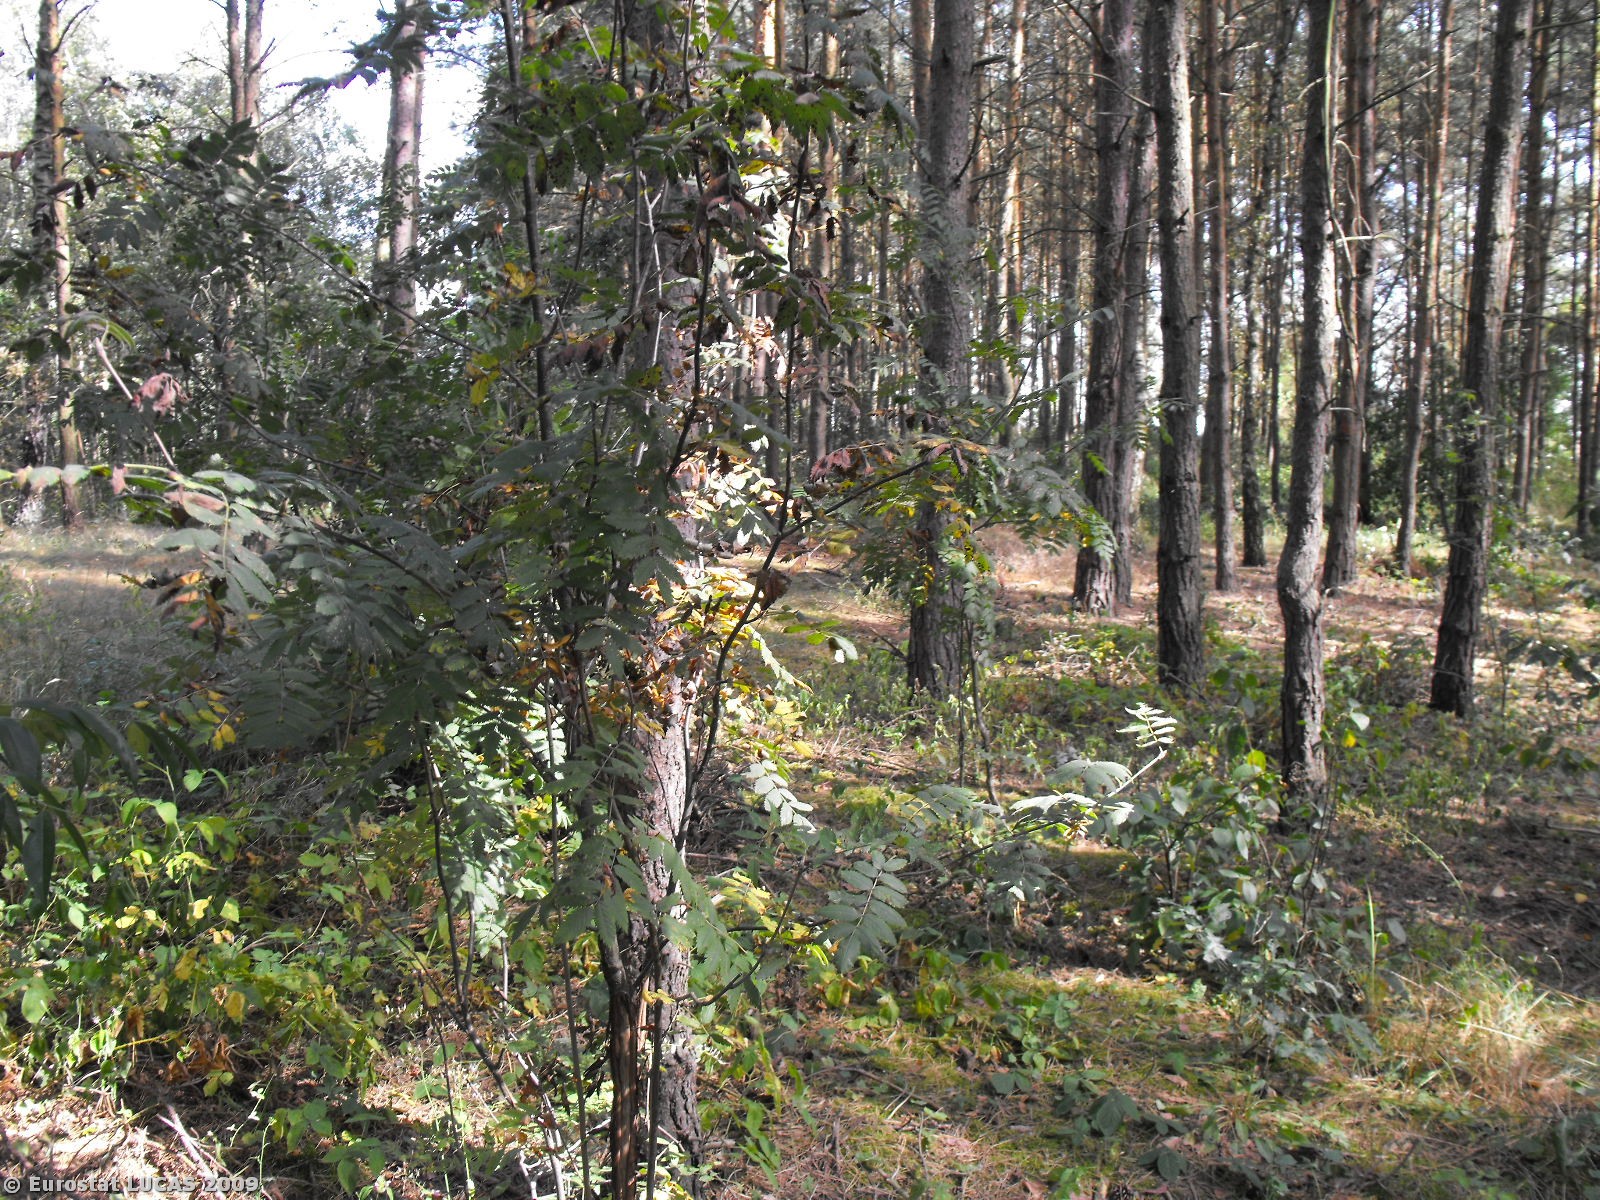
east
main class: Woodland
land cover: Mixed woodland
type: hemiboreal forest and nemoral coniferous forest and mixed broadleaved-coniferous forest
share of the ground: > 75 %
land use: Forestry
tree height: > 5 m
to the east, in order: Mixed woodland; Tracks; Mixed woodland; Grass margins; Barley; Grass margins; Fences; Other fruit trees and berries
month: August
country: PL
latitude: 52.8488
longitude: 16.4962
